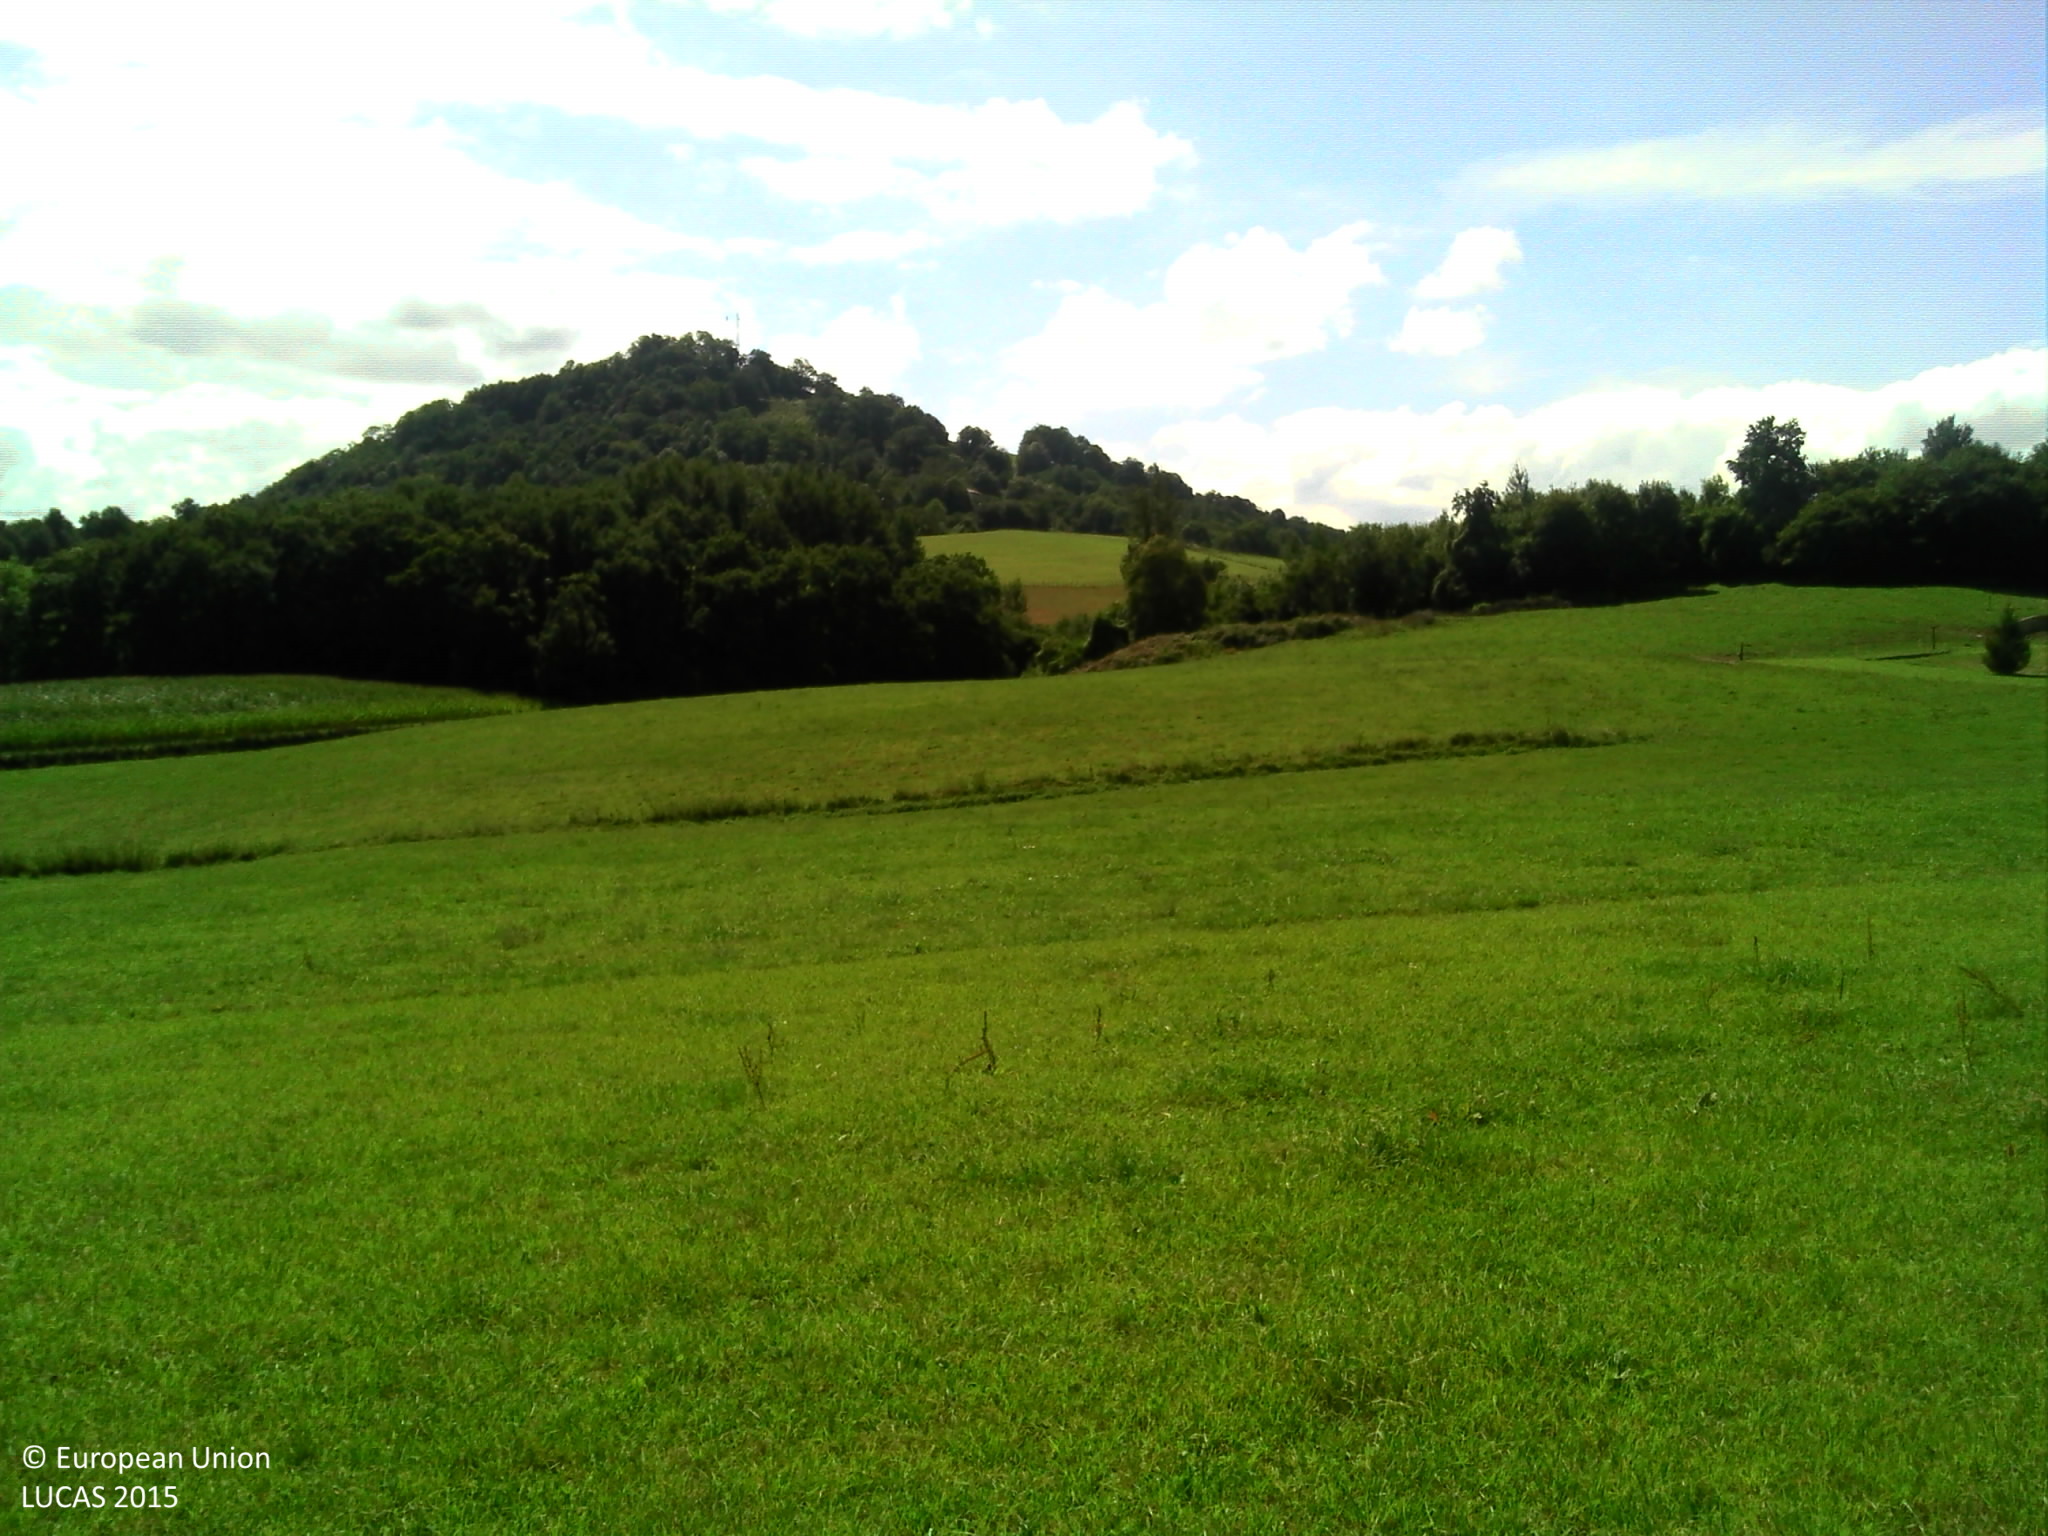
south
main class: Grassland
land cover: Grassland without tree/shrub cover
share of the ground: > 75 %
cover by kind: herbaceous plants 100 %
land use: Agriculture (excluding fallow land and kitchen gardens)
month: September
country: FR
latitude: 43.1963
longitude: -1.1994
